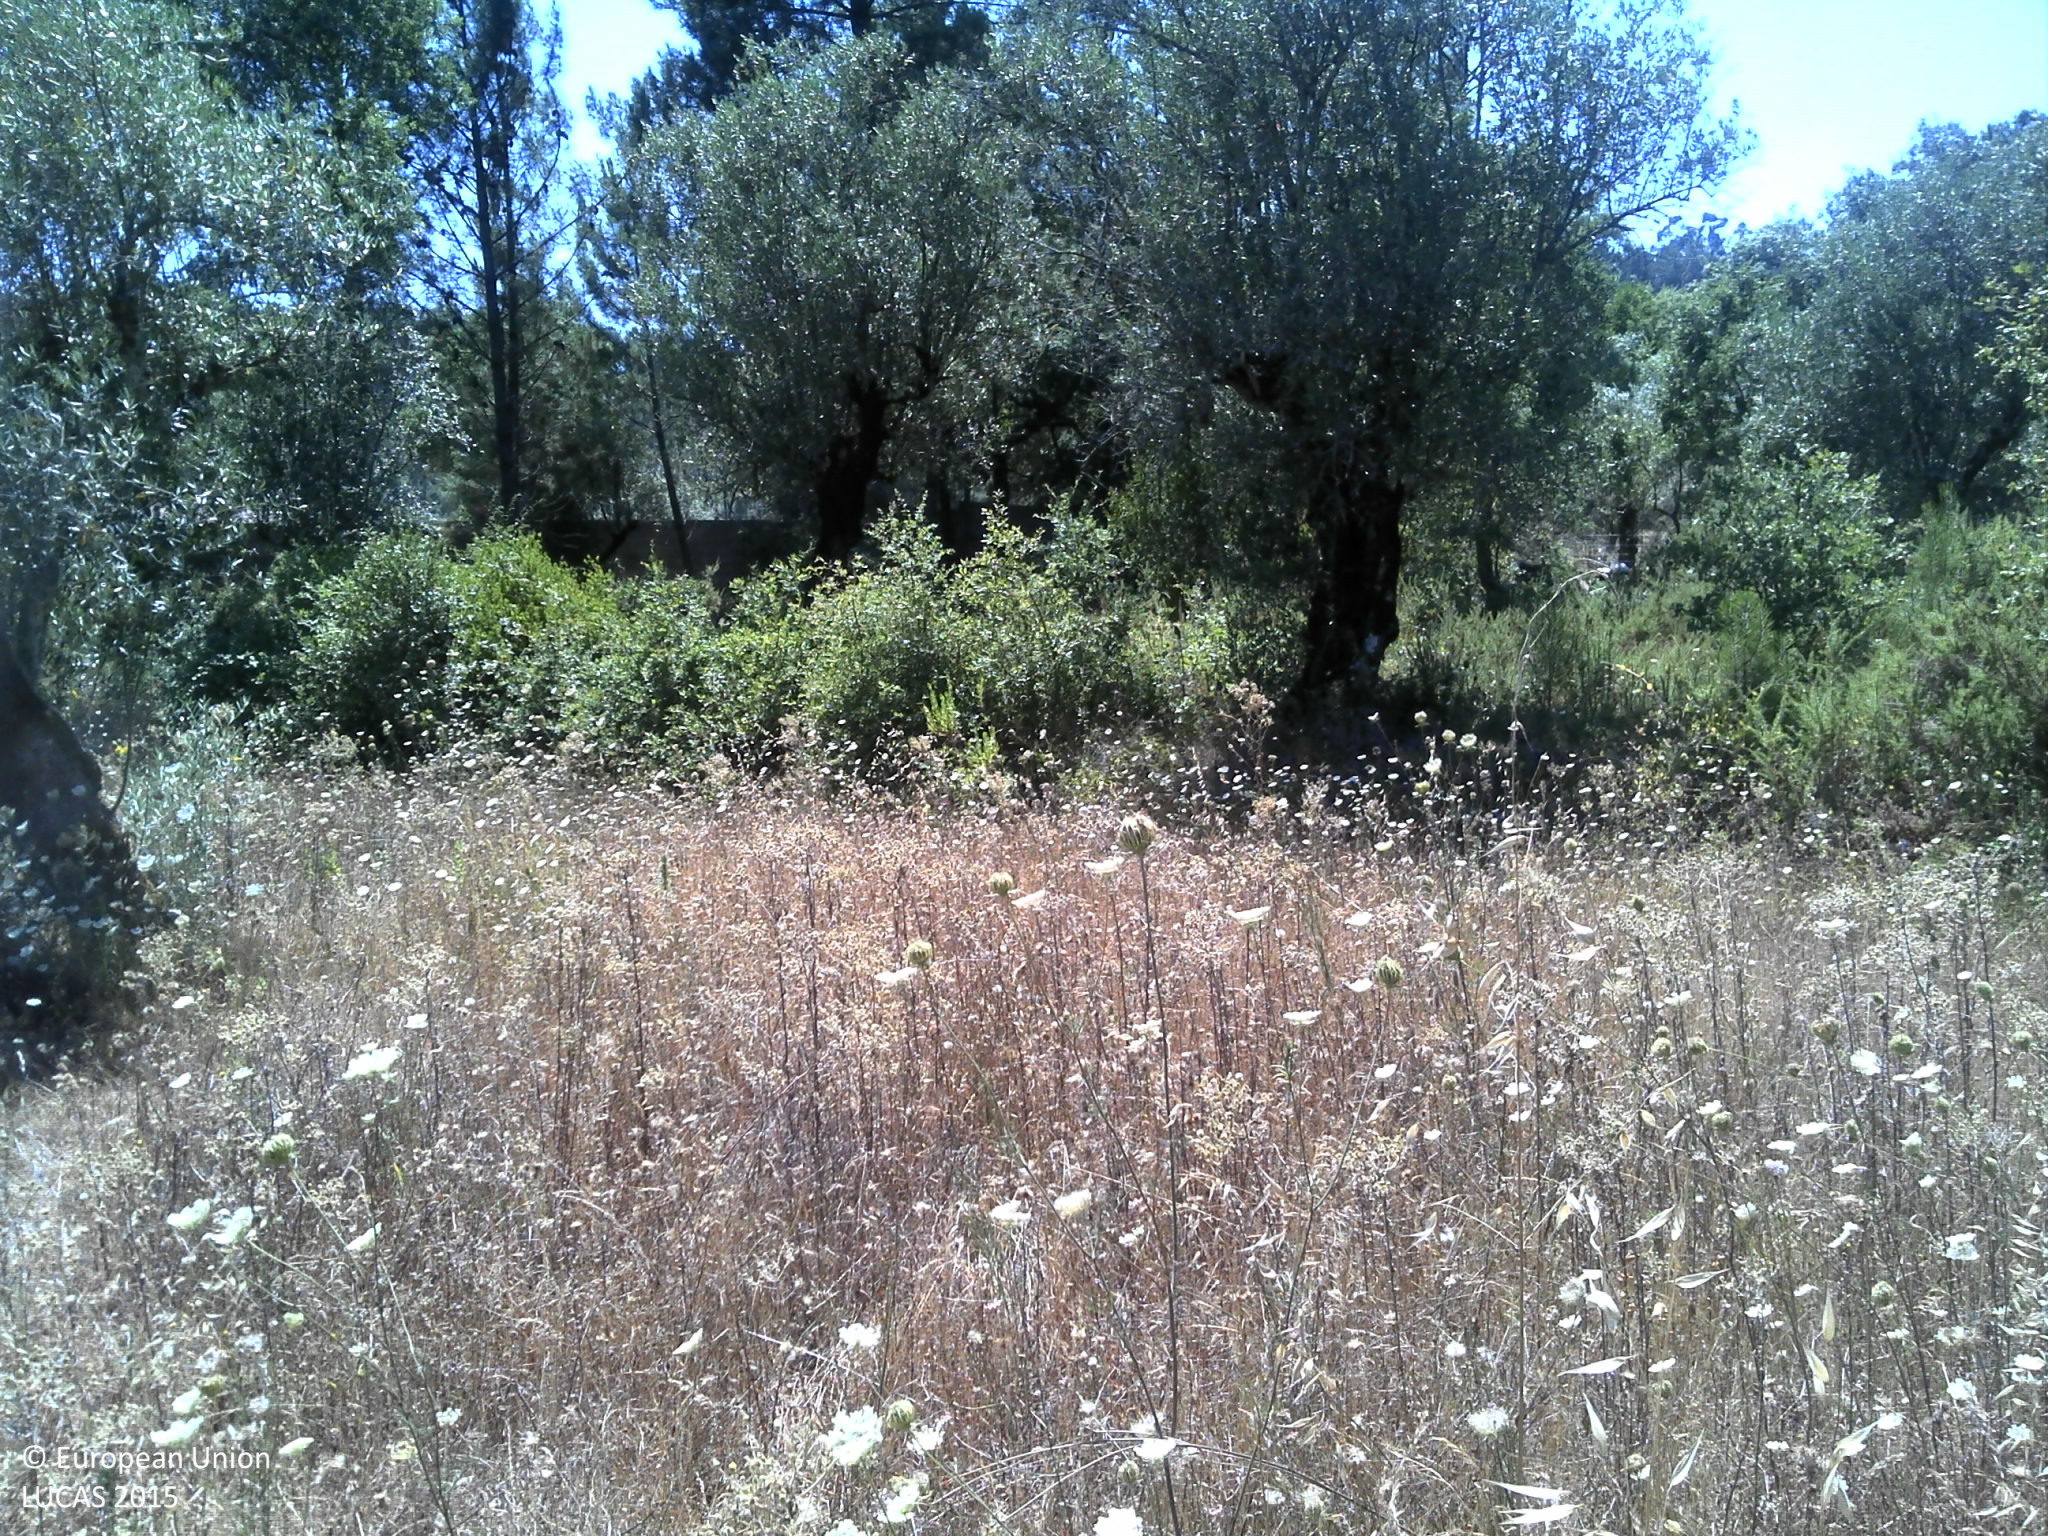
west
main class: Cropland
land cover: Olive groves
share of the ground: 25 - 50 %
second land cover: Grassland without tree/shrub cover
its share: 50 - 75 %
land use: Agriculture (excluding fallow land and kitchen gardens)
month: July
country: PT
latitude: 39.8615
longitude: -8.4903
